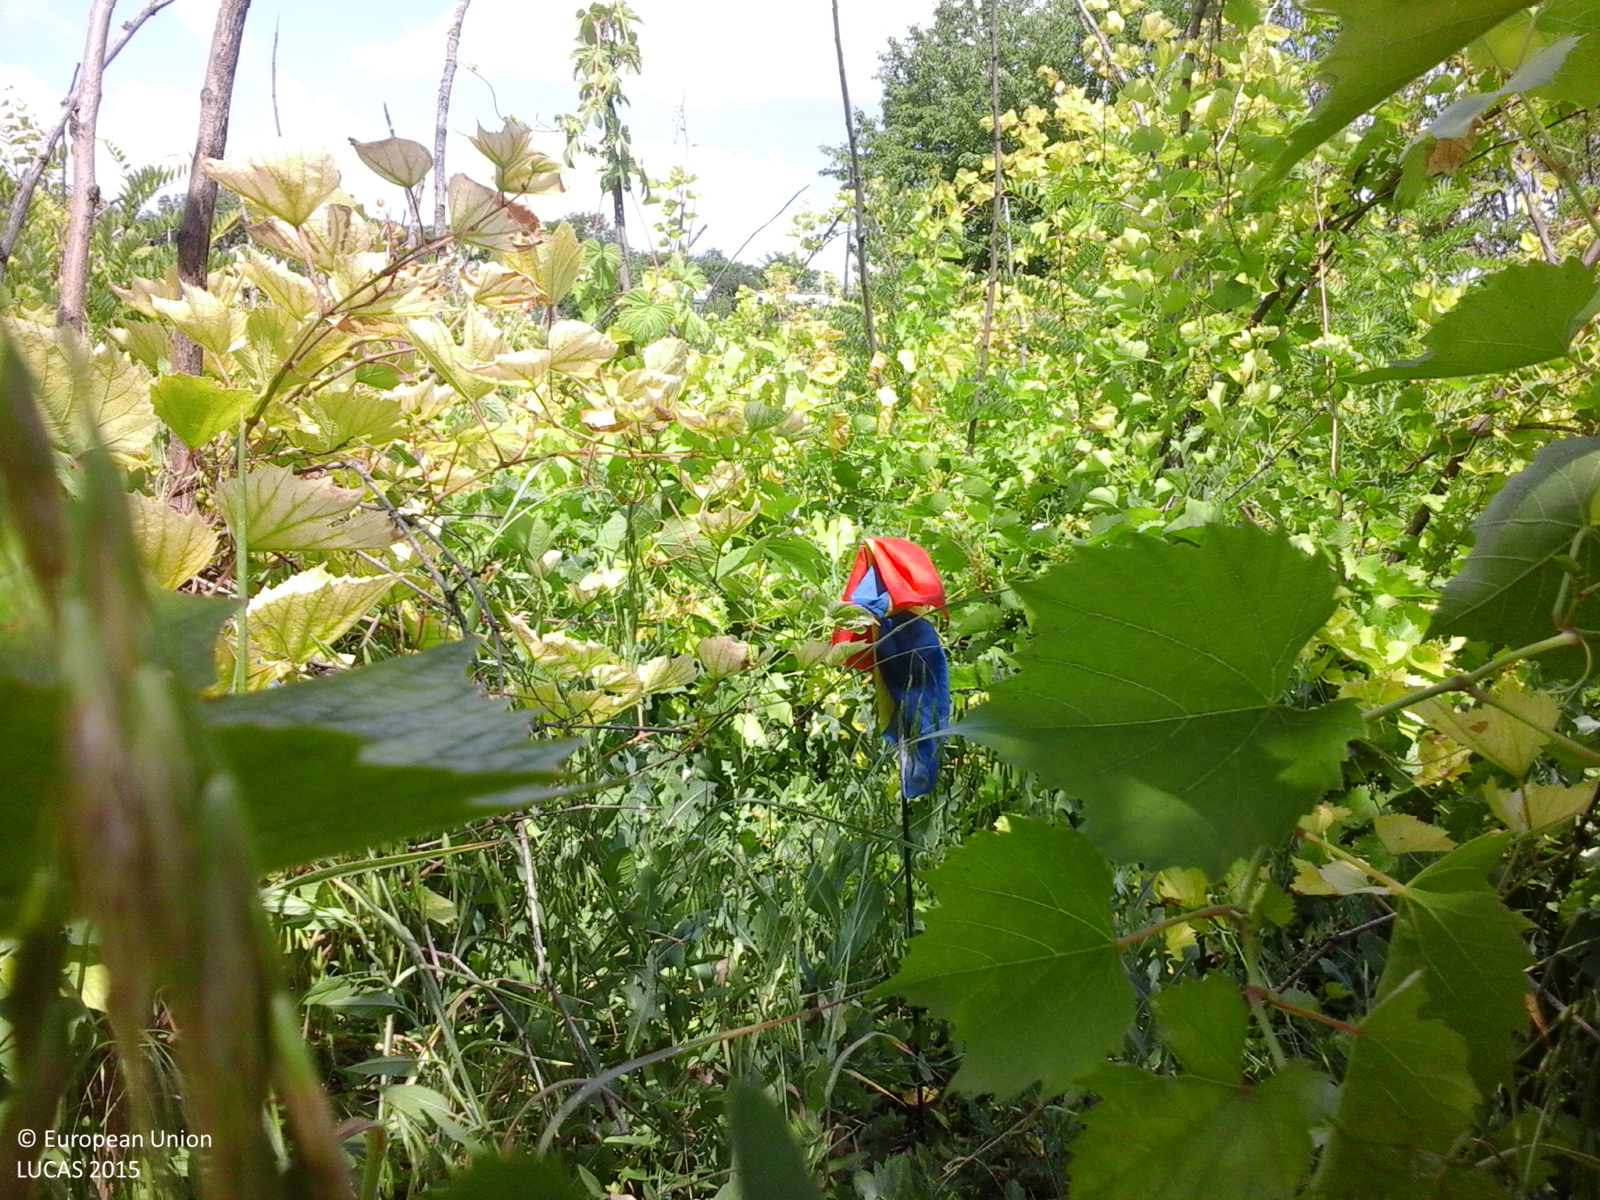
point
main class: Cropland
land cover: Vineyards
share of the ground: 50 - 75 %
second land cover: Grassland without tree/shrub cover
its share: 10 - 25 %
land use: Agriculture (excluding fallow land and kitchen gardens)
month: June
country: RO
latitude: 47.4781
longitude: 26.8858
